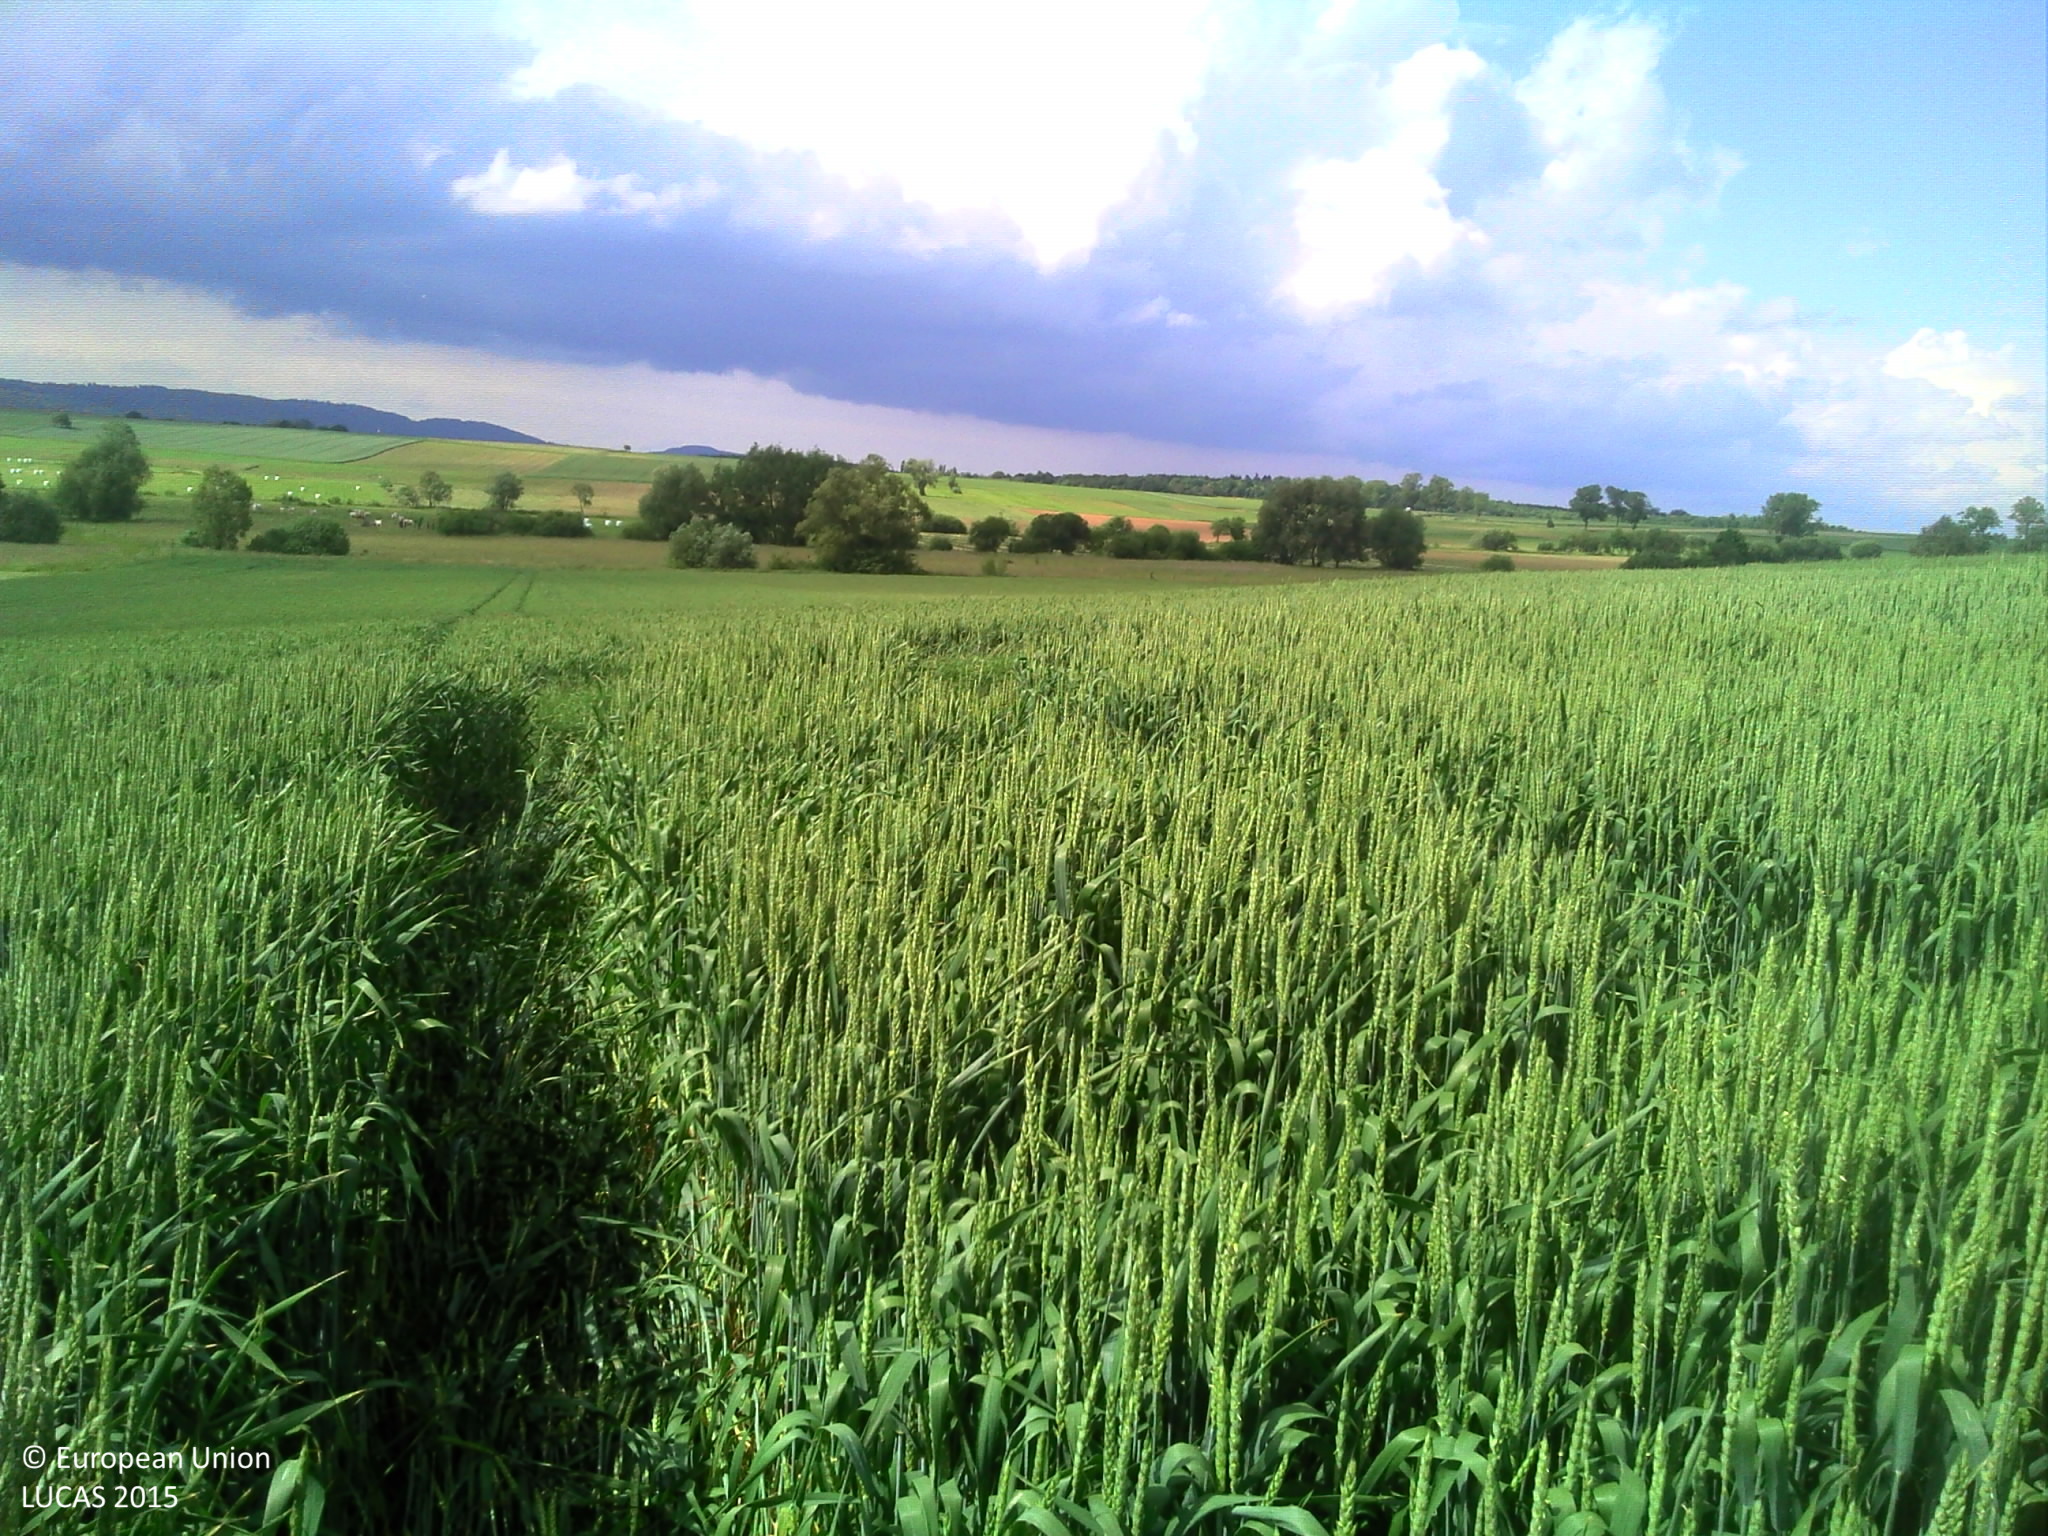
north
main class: Cropland
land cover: Common wheat
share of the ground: > 75 %
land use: Agriculture (excluding fallow land and kitchen gardens)
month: May
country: FR
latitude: 48.7151
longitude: 7.4048
